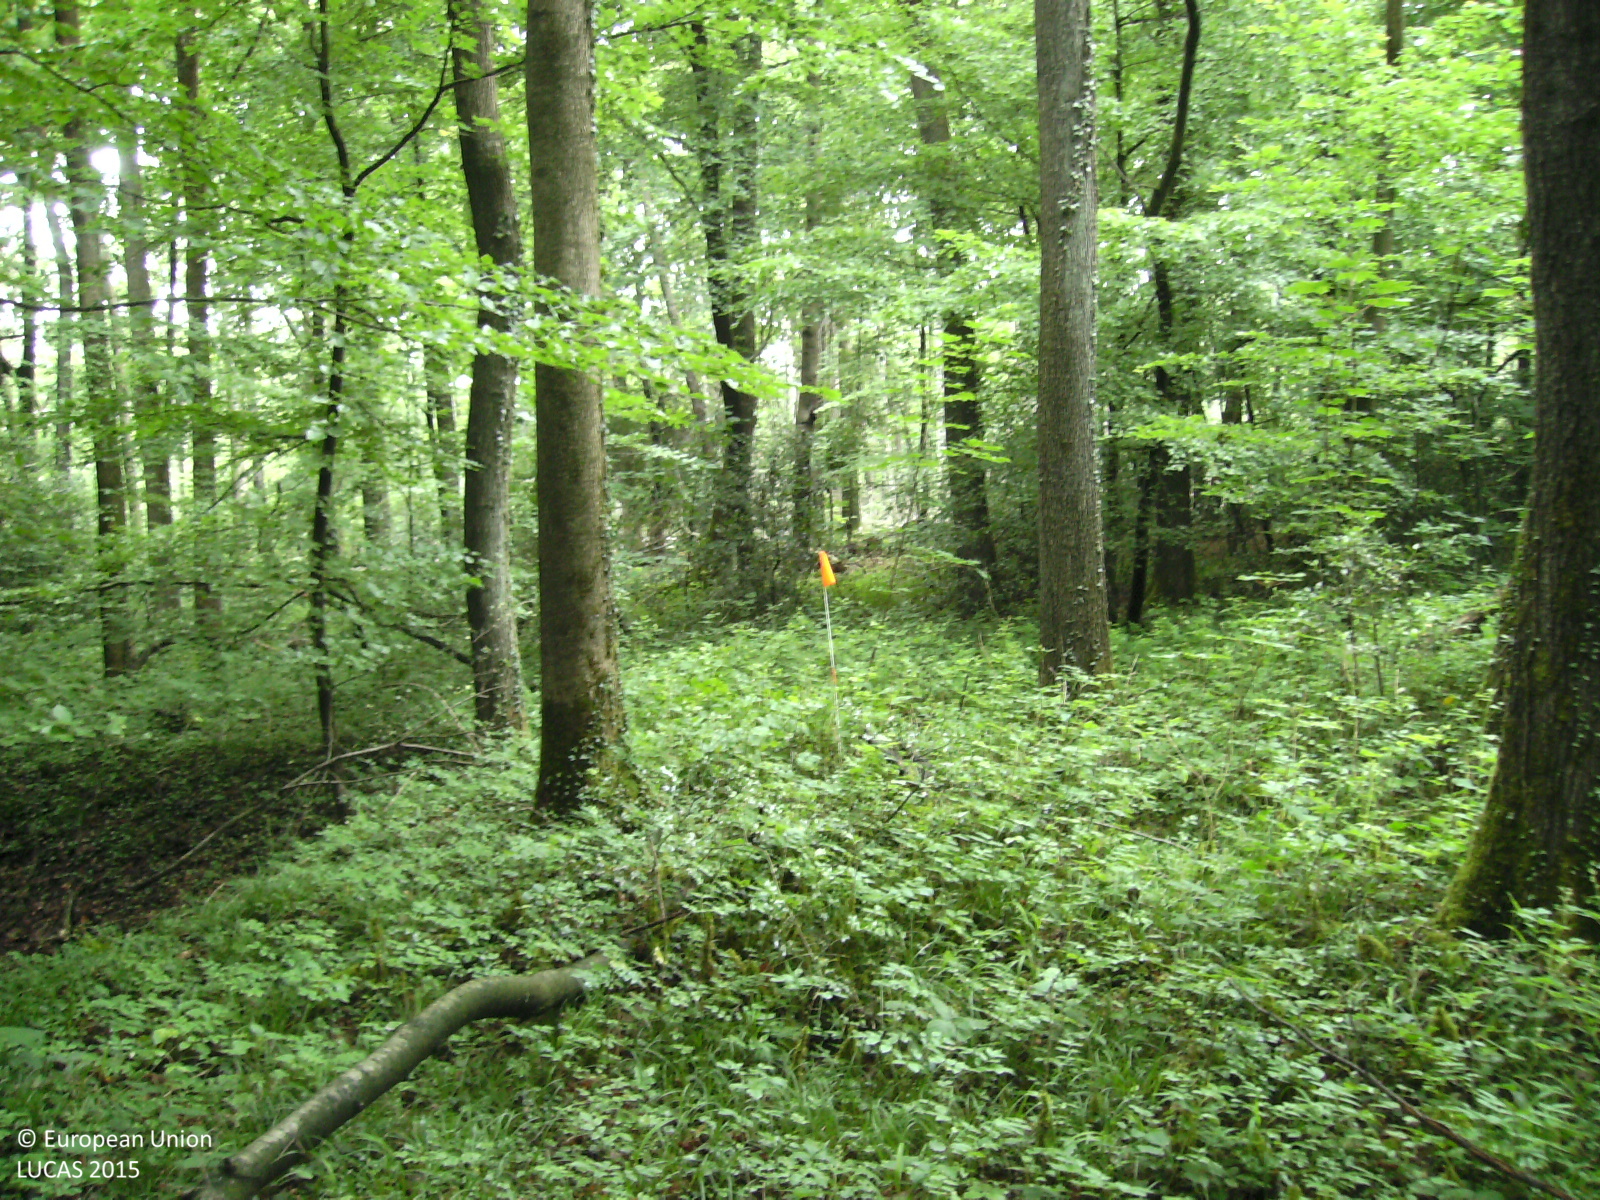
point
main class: Woodland
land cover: Broadleaved woodland
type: mesophytic deciduous forest
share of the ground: > 75 %
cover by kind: broadleaved forest trees 100 %
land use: Forestry
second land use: Amenities, museums, leisure
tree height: > 5 m
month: June
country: DE
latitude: 51.2253
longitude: 7.0359
